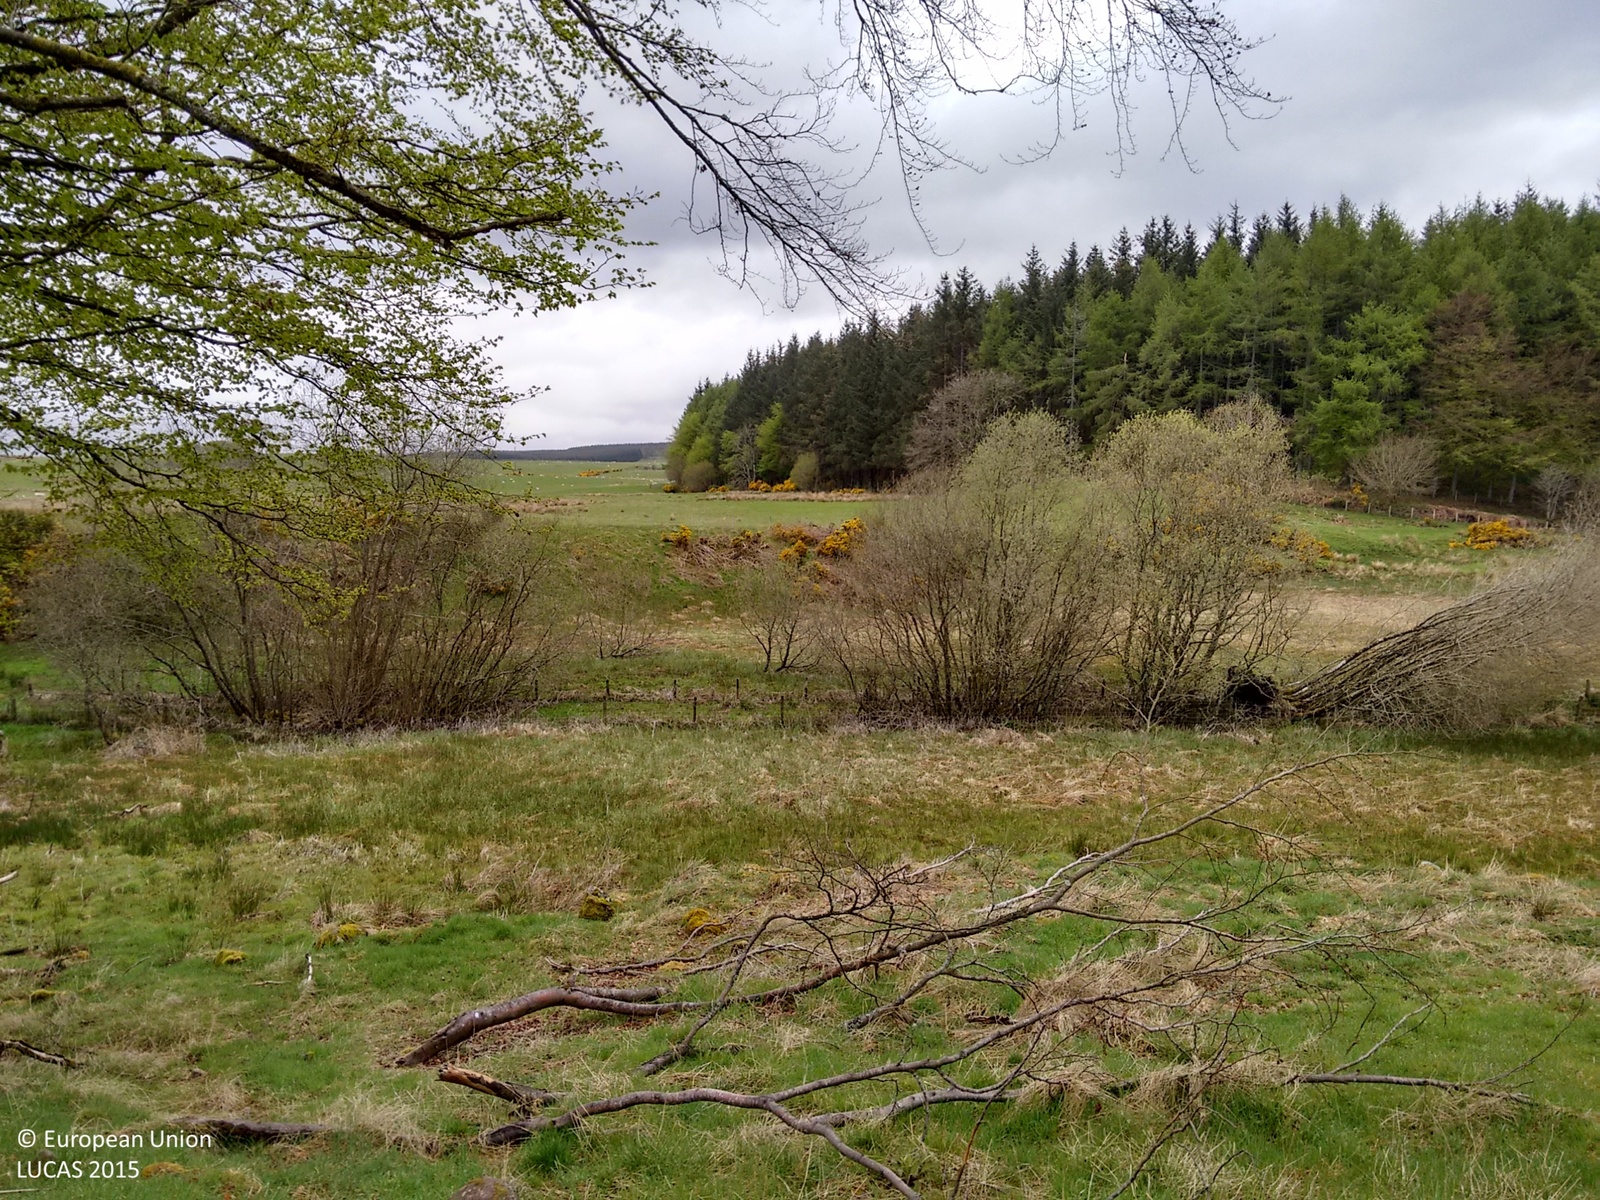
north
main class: Grassland
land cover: Grassland without tree/shrub cover
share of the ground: > 75 %
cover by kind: herbaceous plants 100 %
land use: Agriculture (excluding fallow land and kitchen gardens)
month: May
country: GB
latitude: 56.2086
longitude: -4.0983
